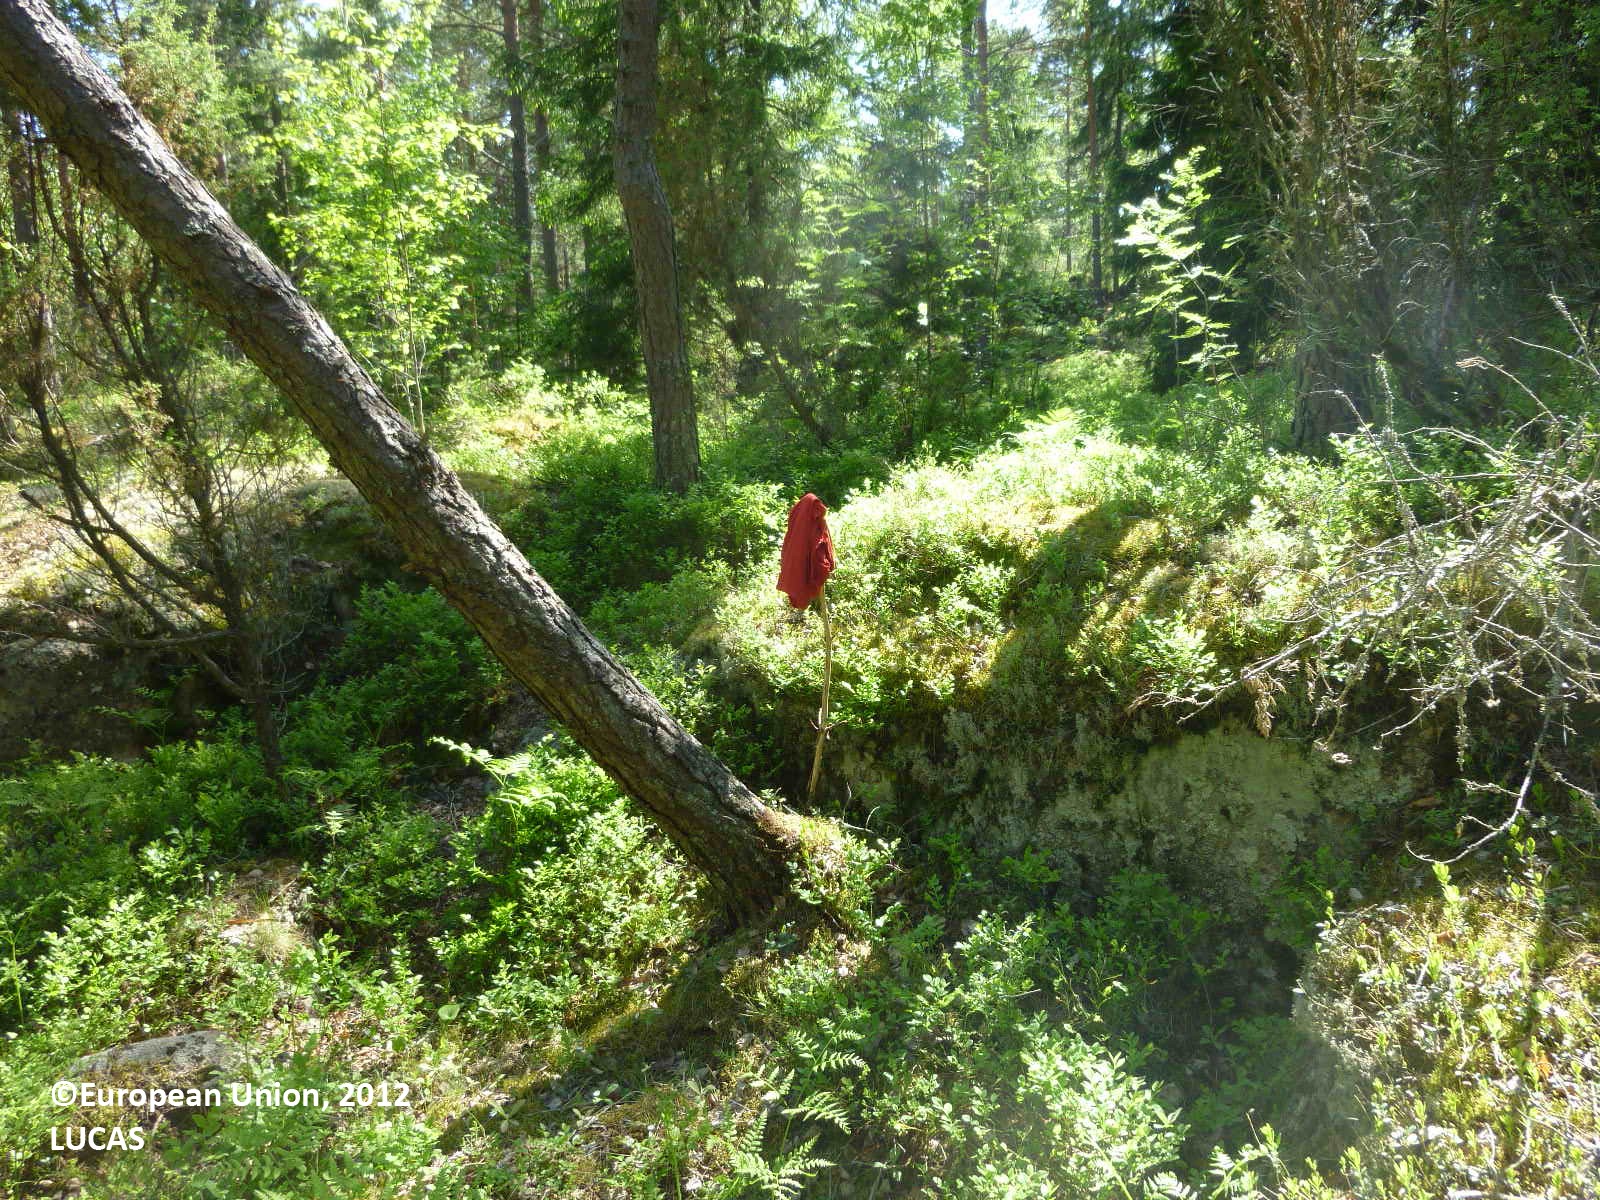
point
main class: Woodland
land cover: Pine dominated coniferous woodland
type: boreal forest
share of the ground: 50 - 75 %
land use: Forestry
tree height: > 5 m
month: June
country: FI
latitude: 60.4148
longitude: 22.6197
